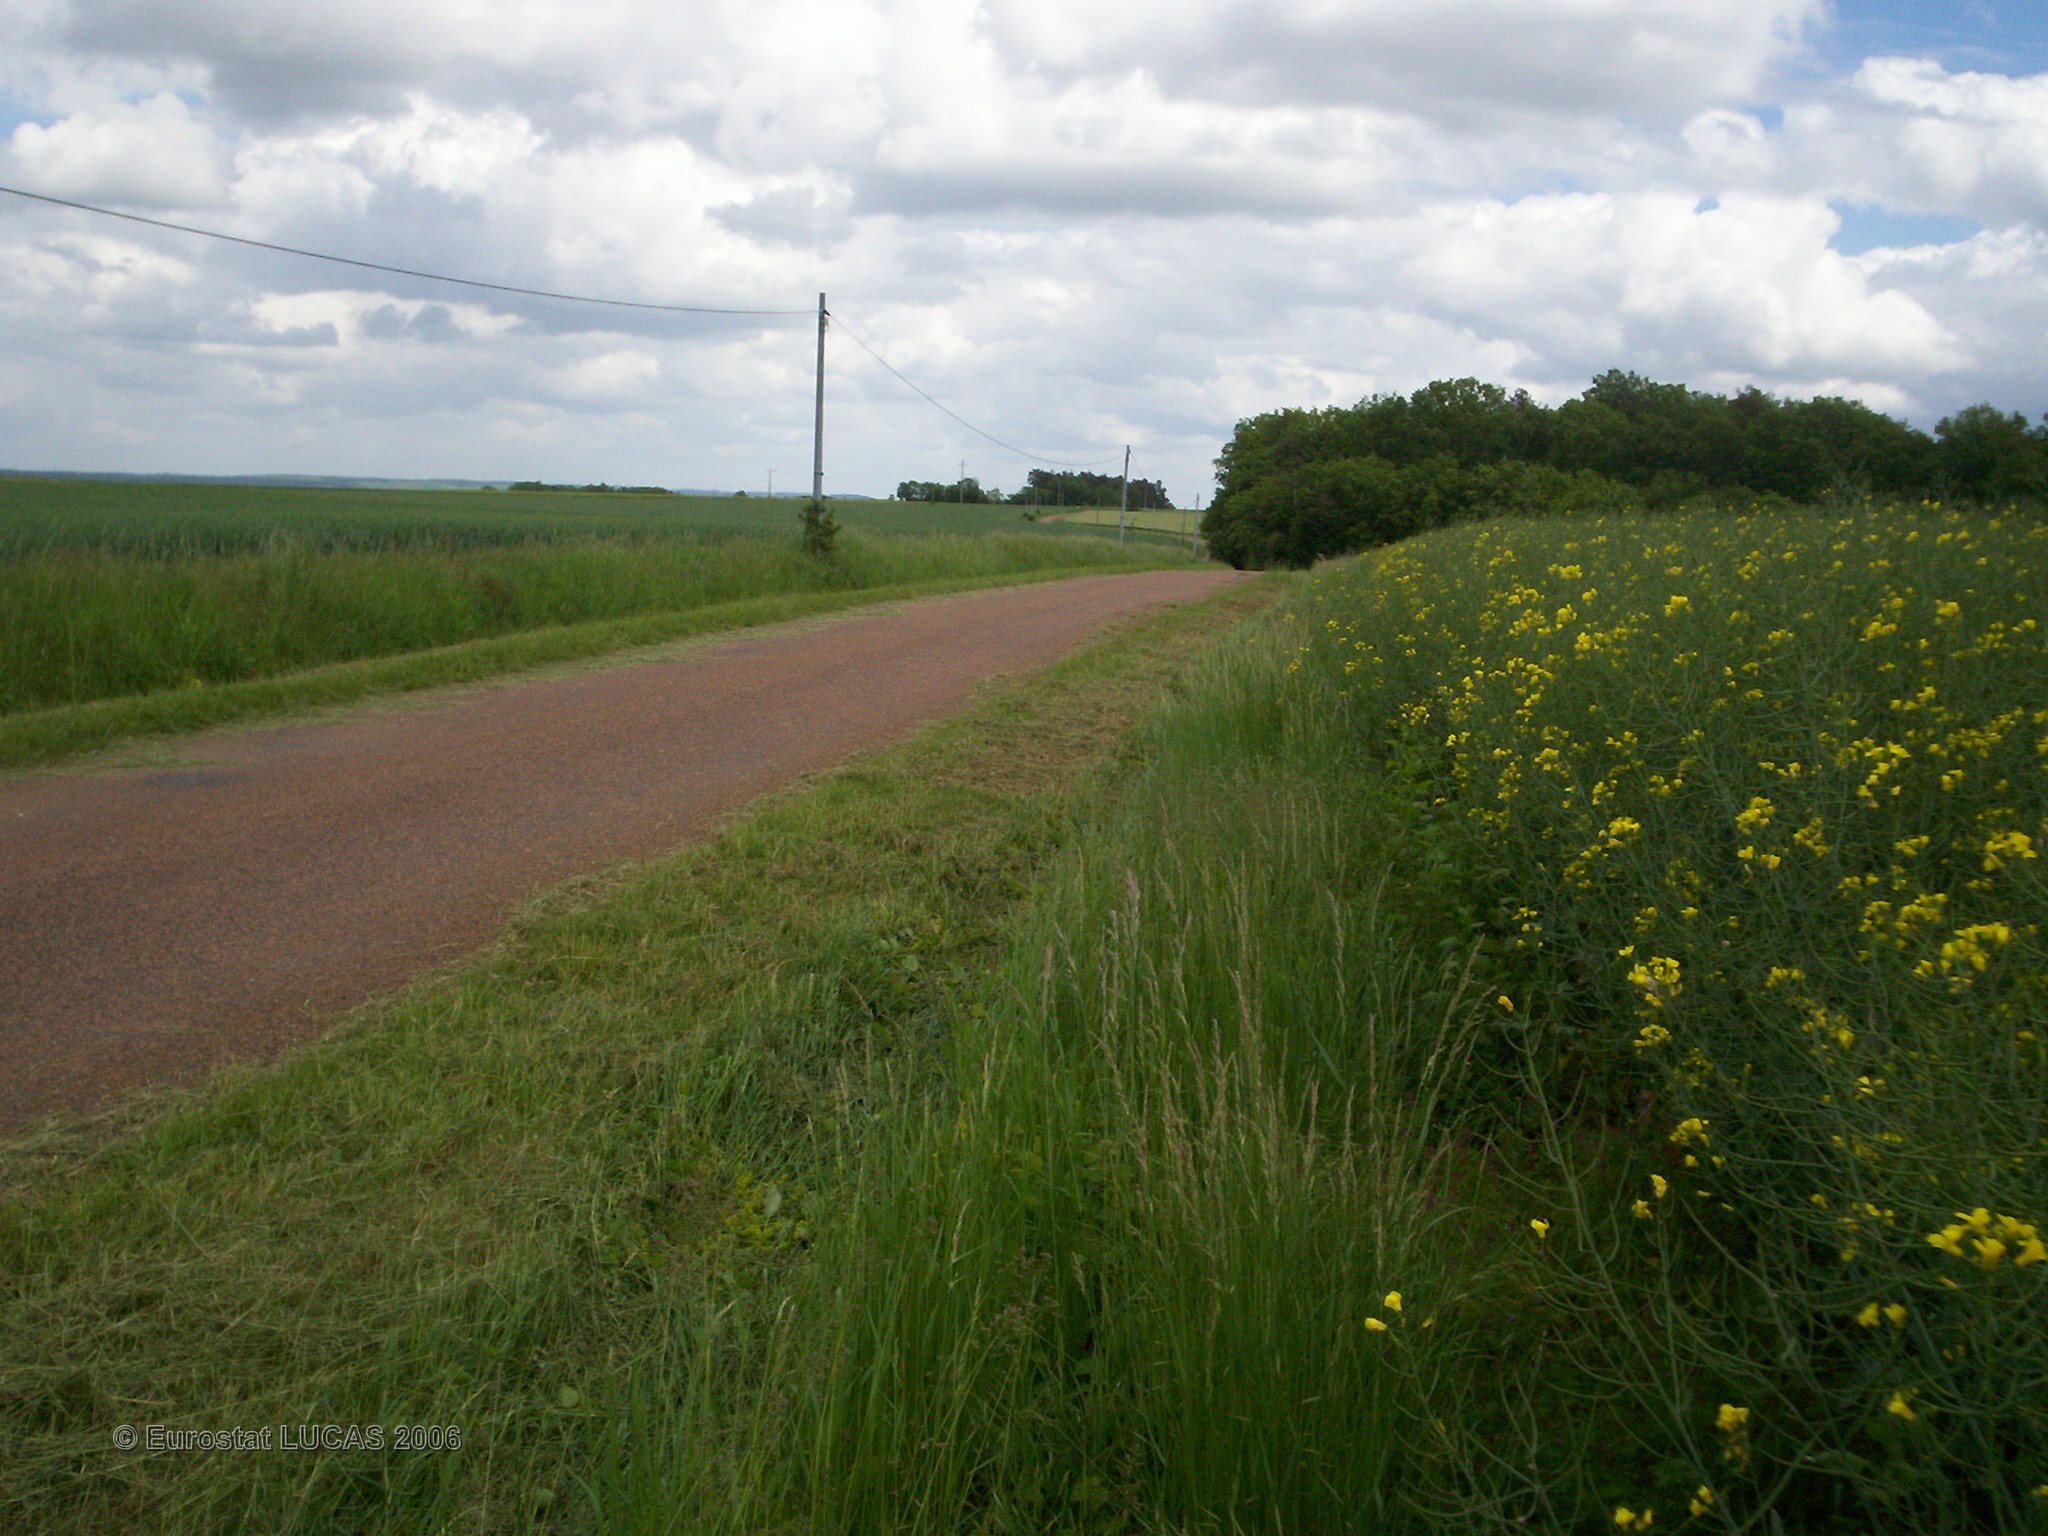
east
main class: Cropland
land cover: Rape and turnip rape
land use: Agriculture (excluding fallow land and kitchen gardens)
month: May
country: FR
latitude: 47.7567
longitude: 4.0610
